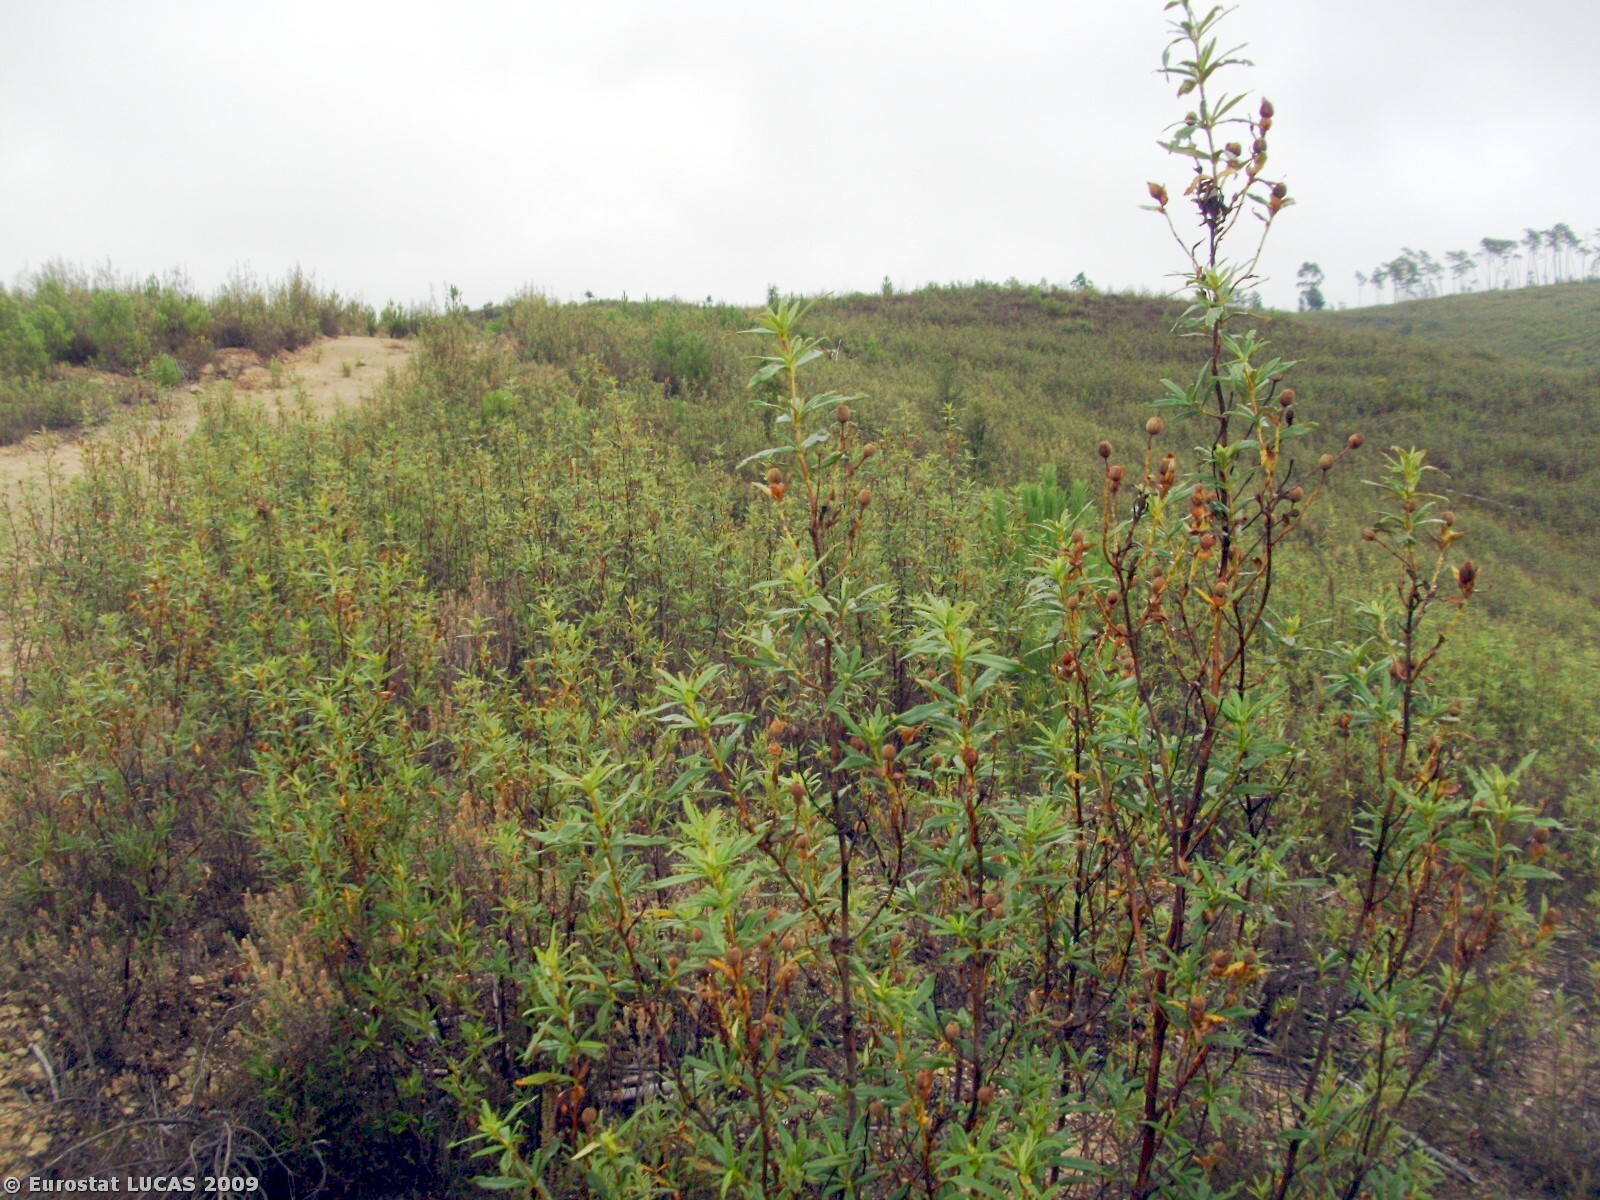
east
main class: Shrubland
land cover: Shrubland with sparse tree cover
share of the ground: > 75 %
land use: Unused
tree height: > 5 m
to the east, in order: Shrubland with sparse tree cover; Tracks; Shrubland with sparse tree cover; Tracks; Shrubland with sparse tree cover; Tracks; Shrubland with sparse tree cover
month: July
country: PT
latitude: 39.7162
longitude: -8.0881
